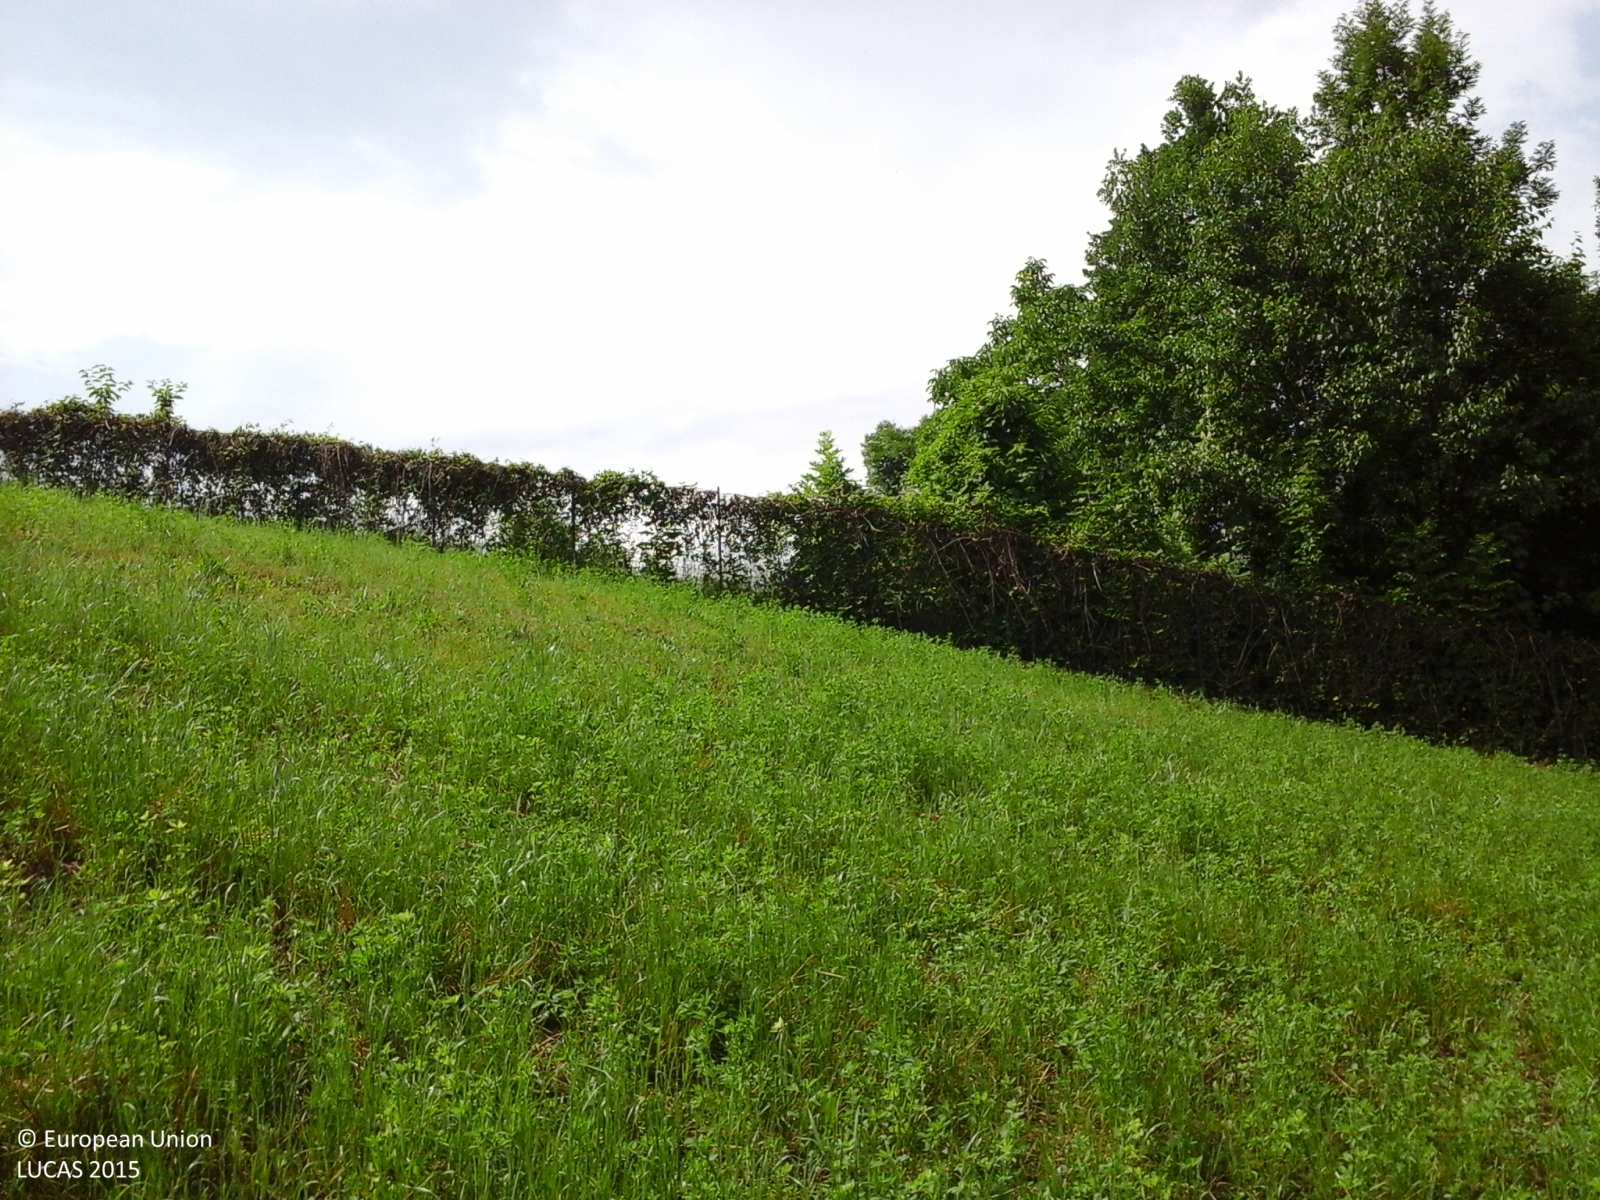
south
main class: Cropland
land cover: Lucerne
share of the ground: > 75 %
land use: Agriculture (excluding fallow land and kitchen gardens)
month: June
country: IT
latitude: 44.8006
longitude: 9.6089
